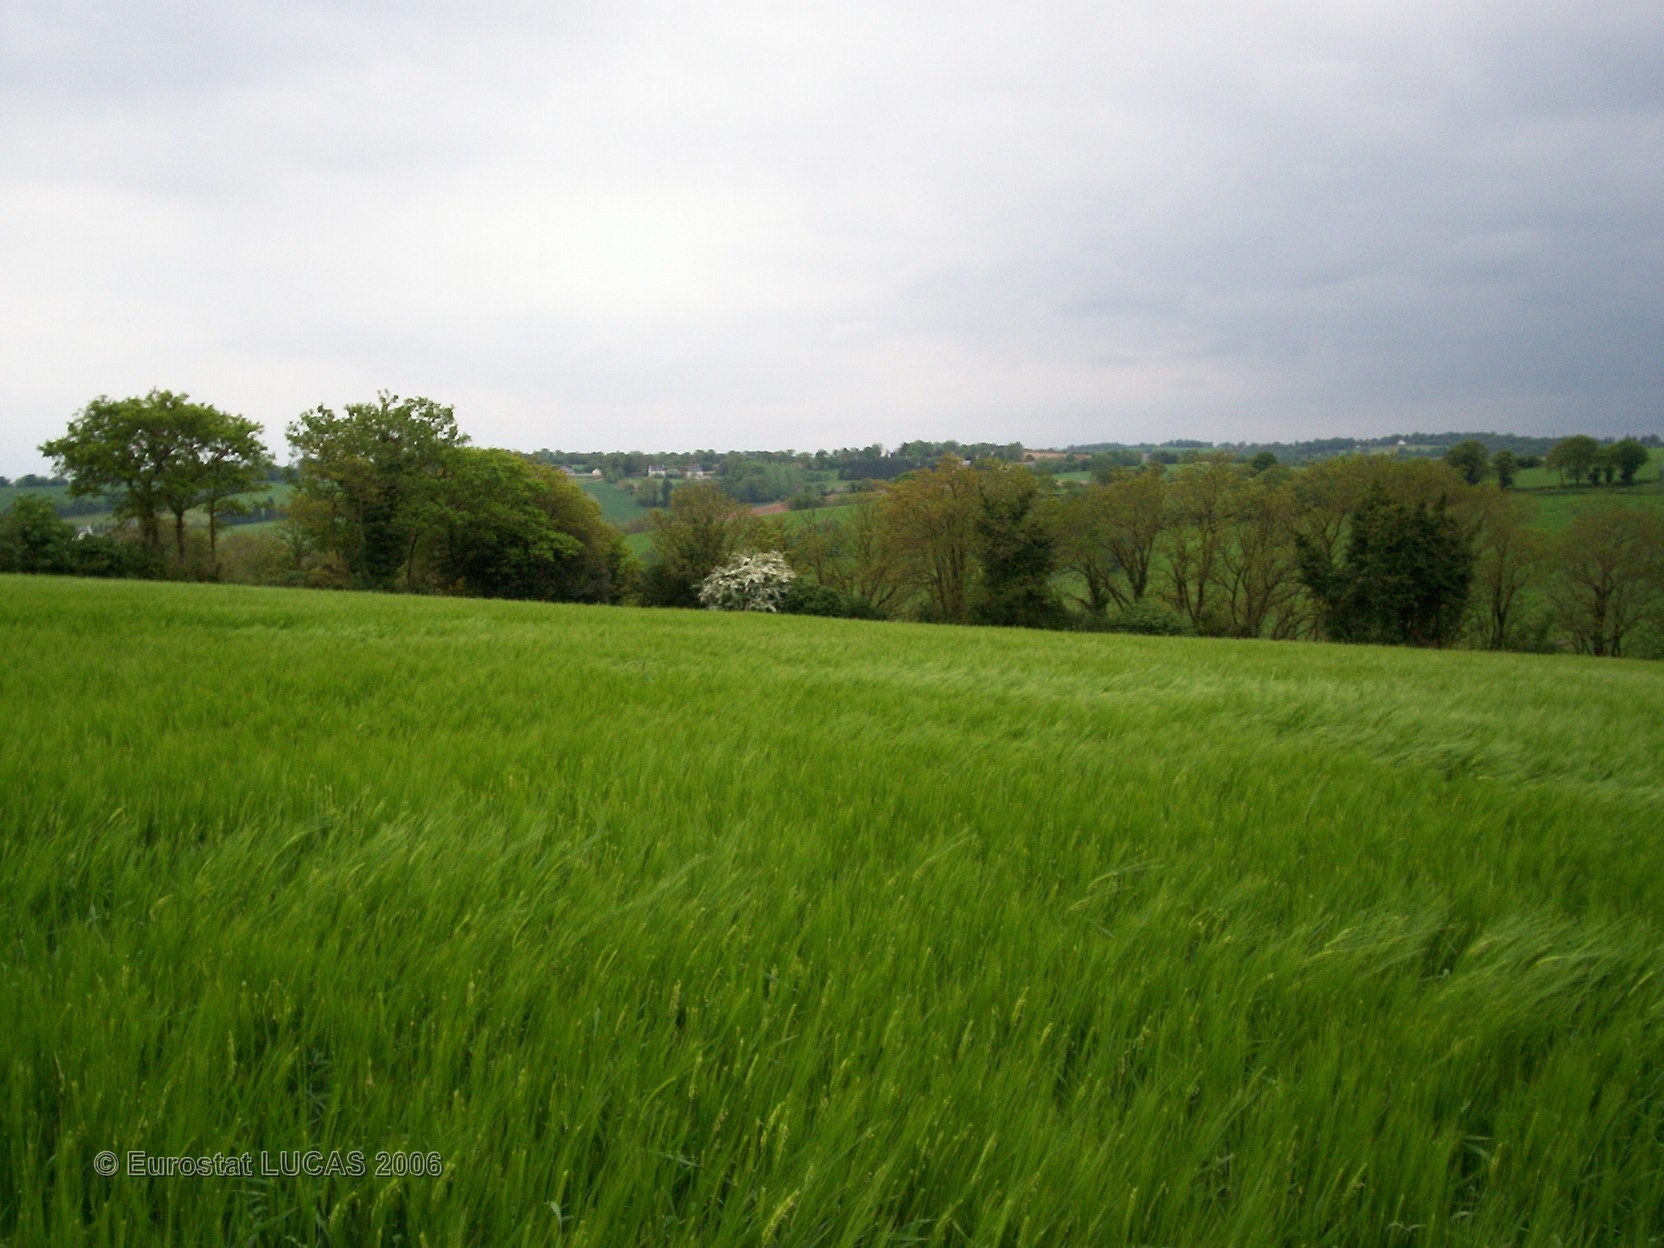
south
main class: Cropland
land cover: Barley
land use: Agriculture (excluding fallow land and kitchen gardens)
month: May
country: FR
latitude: 48.2927
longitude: -3.7092
